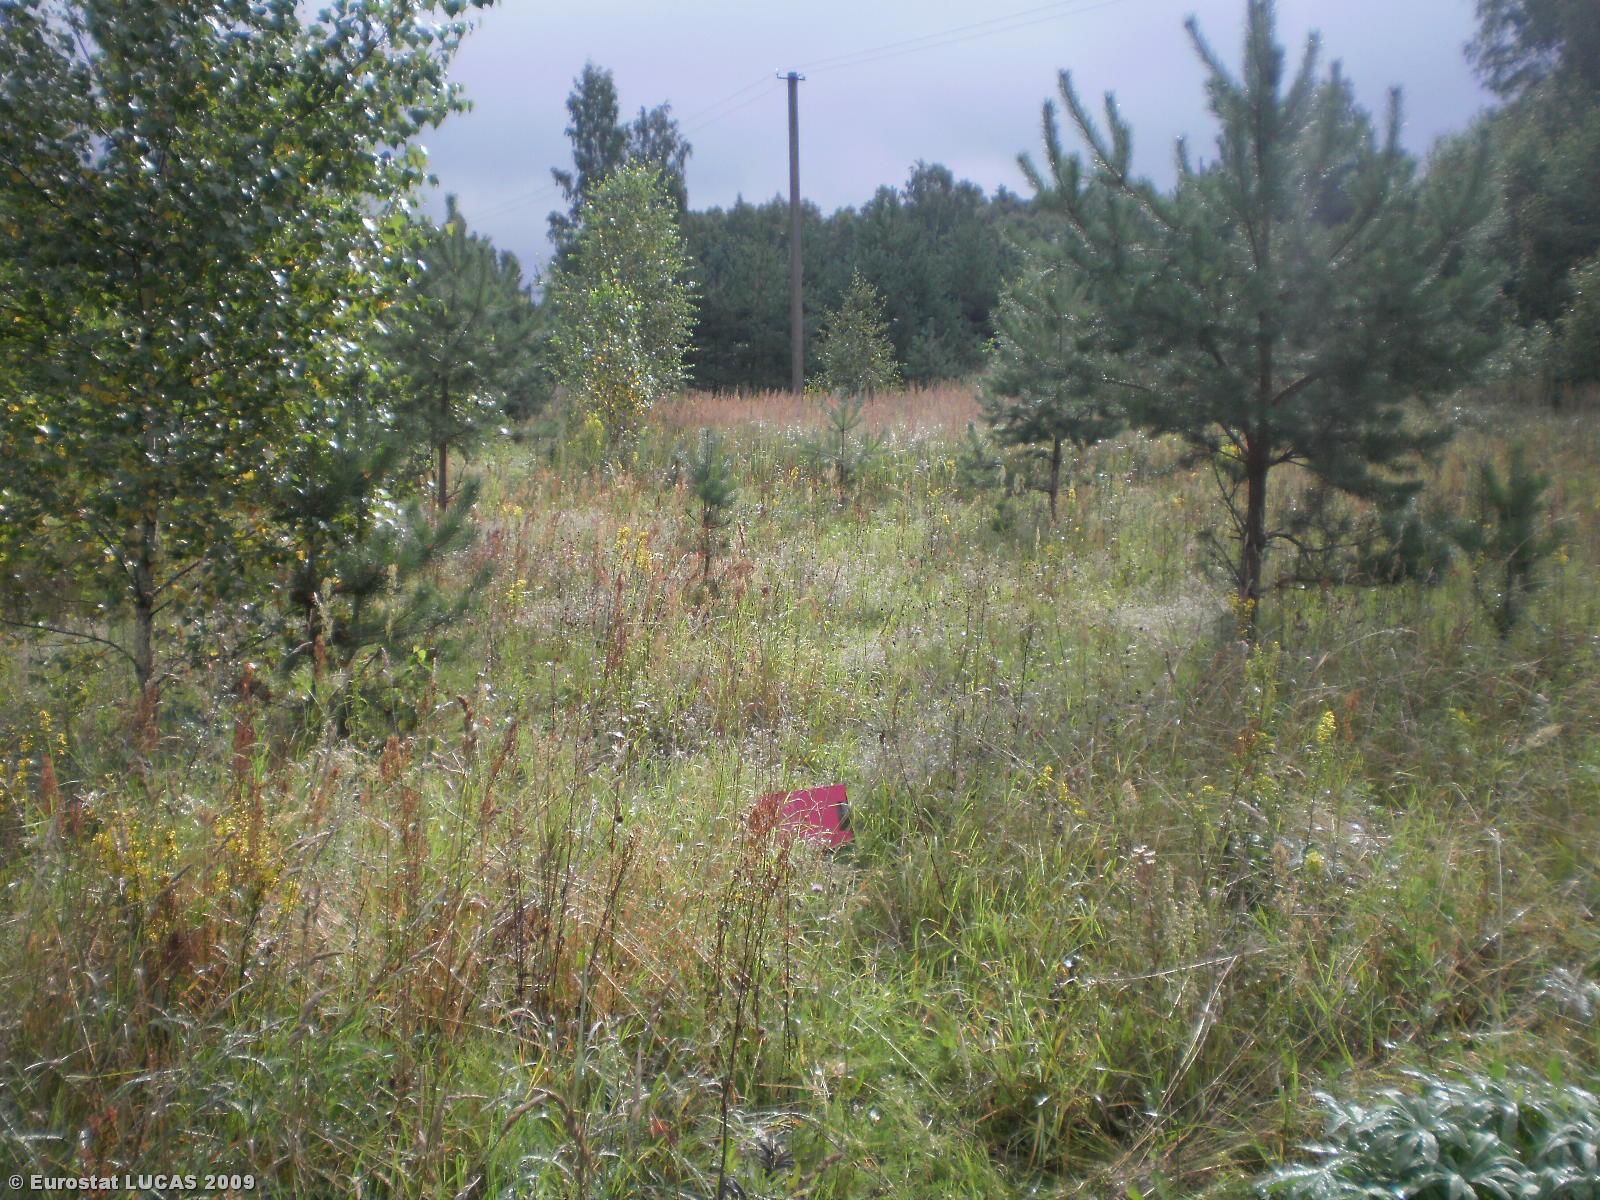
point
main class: Grassland
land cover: Grassland with sparse tree/shrub cover
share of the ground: > 75 %
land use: Forestry
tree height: > 5 m
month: August
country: LT
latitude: 55.2988
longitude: 25.4489
